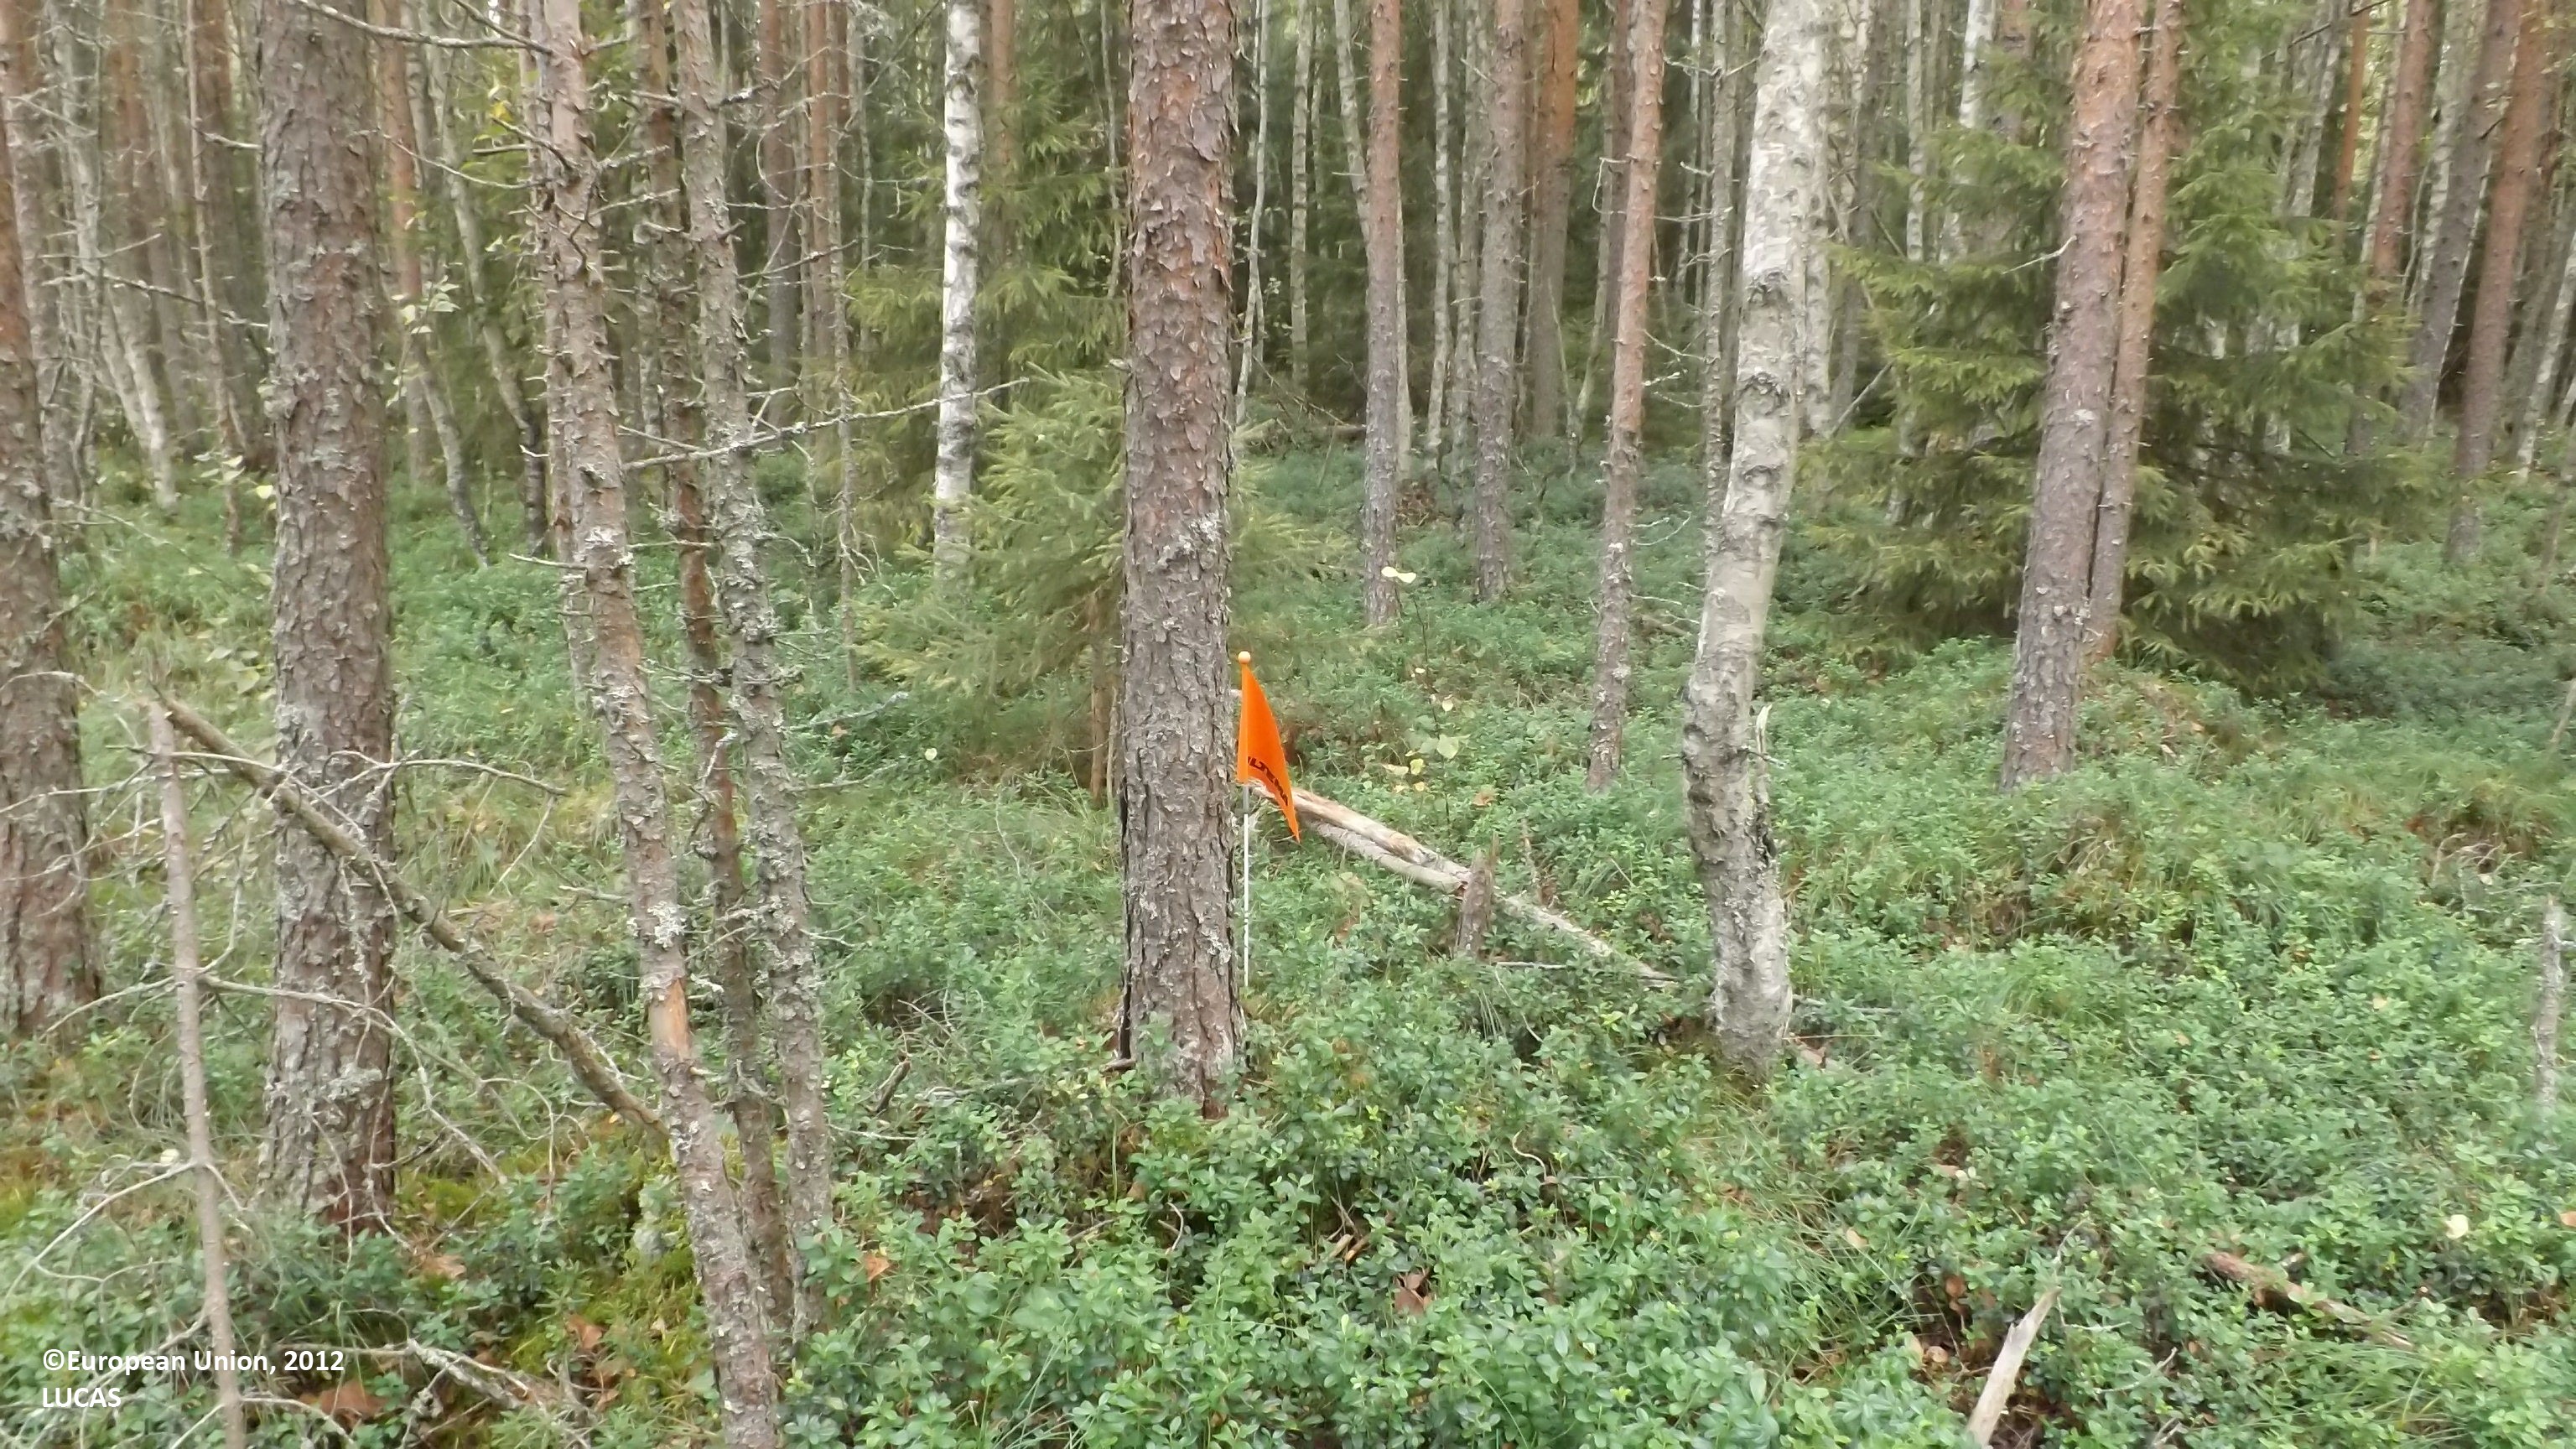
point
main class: Woodland
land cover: Pine dominated mixed woodland
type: boreal forest
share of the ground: > 75 %
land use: Forestry
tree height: > 5 m
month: August
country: FI
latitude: 63.8299
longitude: 23.5743
